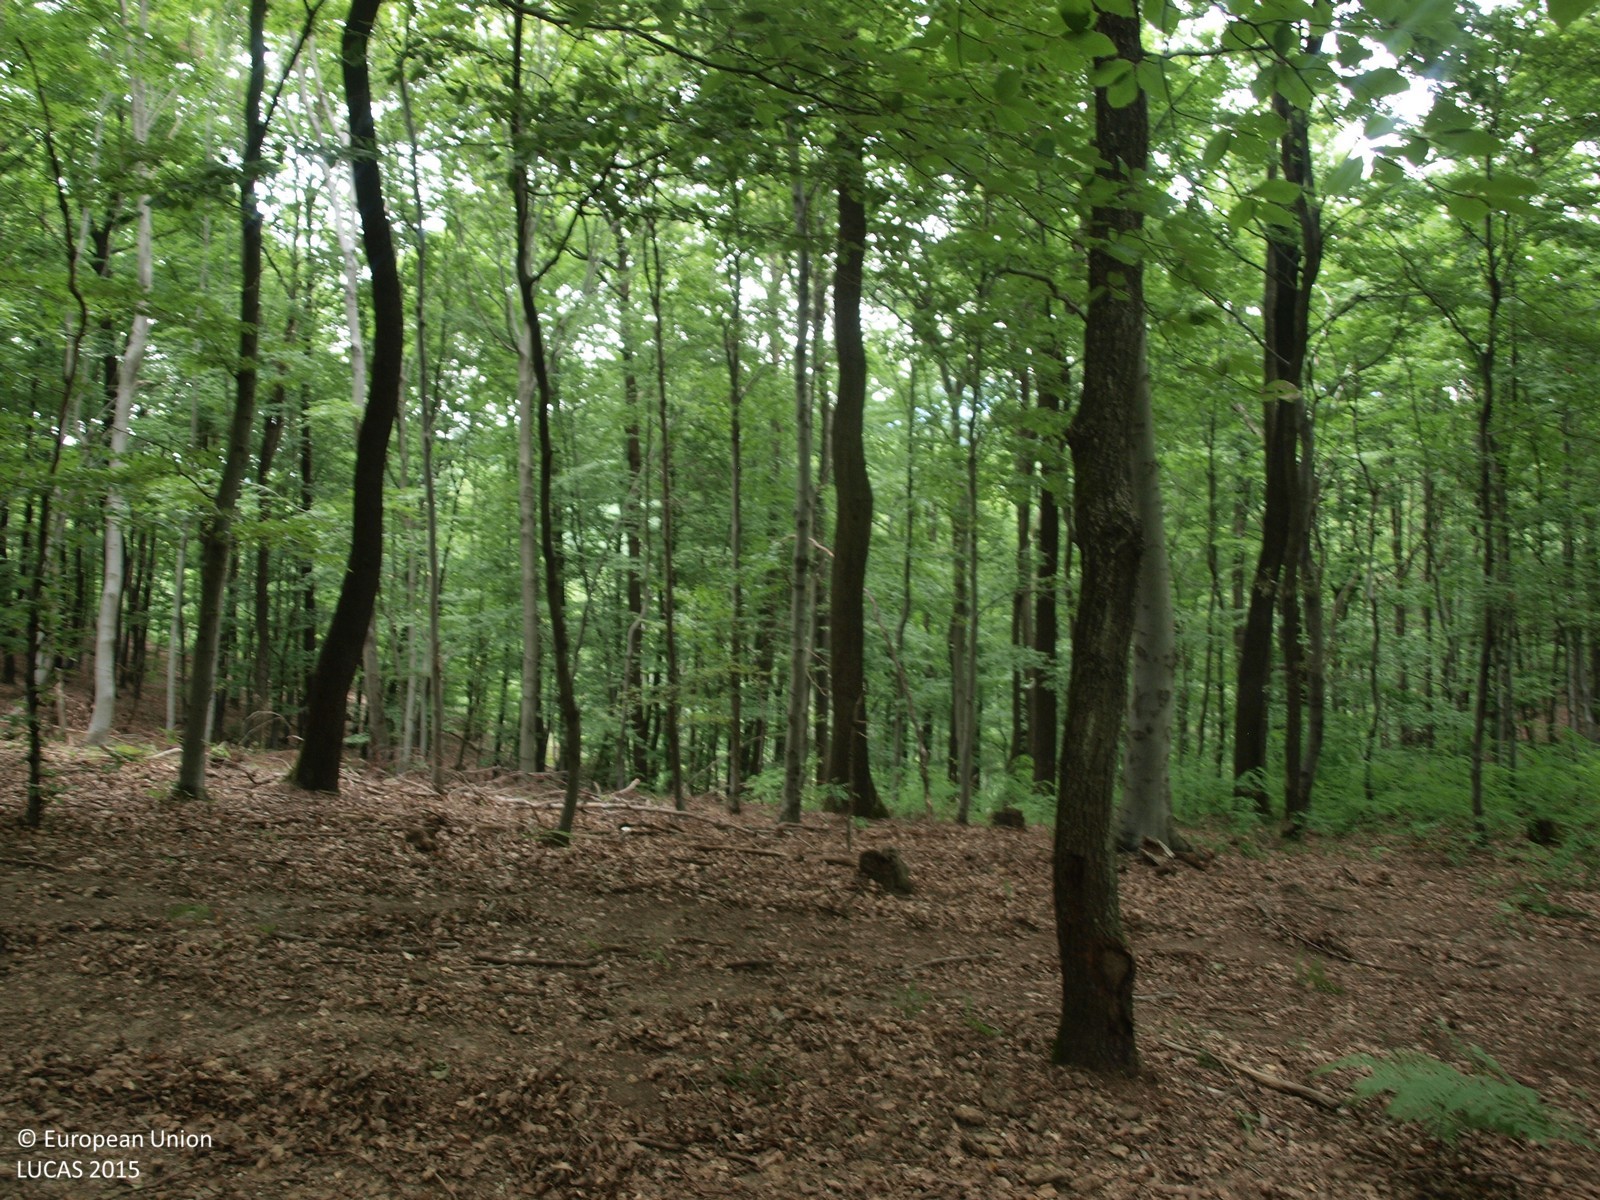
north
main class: Woodland
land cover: Broadleaved woodland
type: mesophytic deciduous forest
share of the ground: > 75 %
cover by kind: broadleaved forest trees 100 %
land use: Forestry
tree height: > 5 m
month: August
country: HR
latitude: 45.8447
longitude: 15.9081
